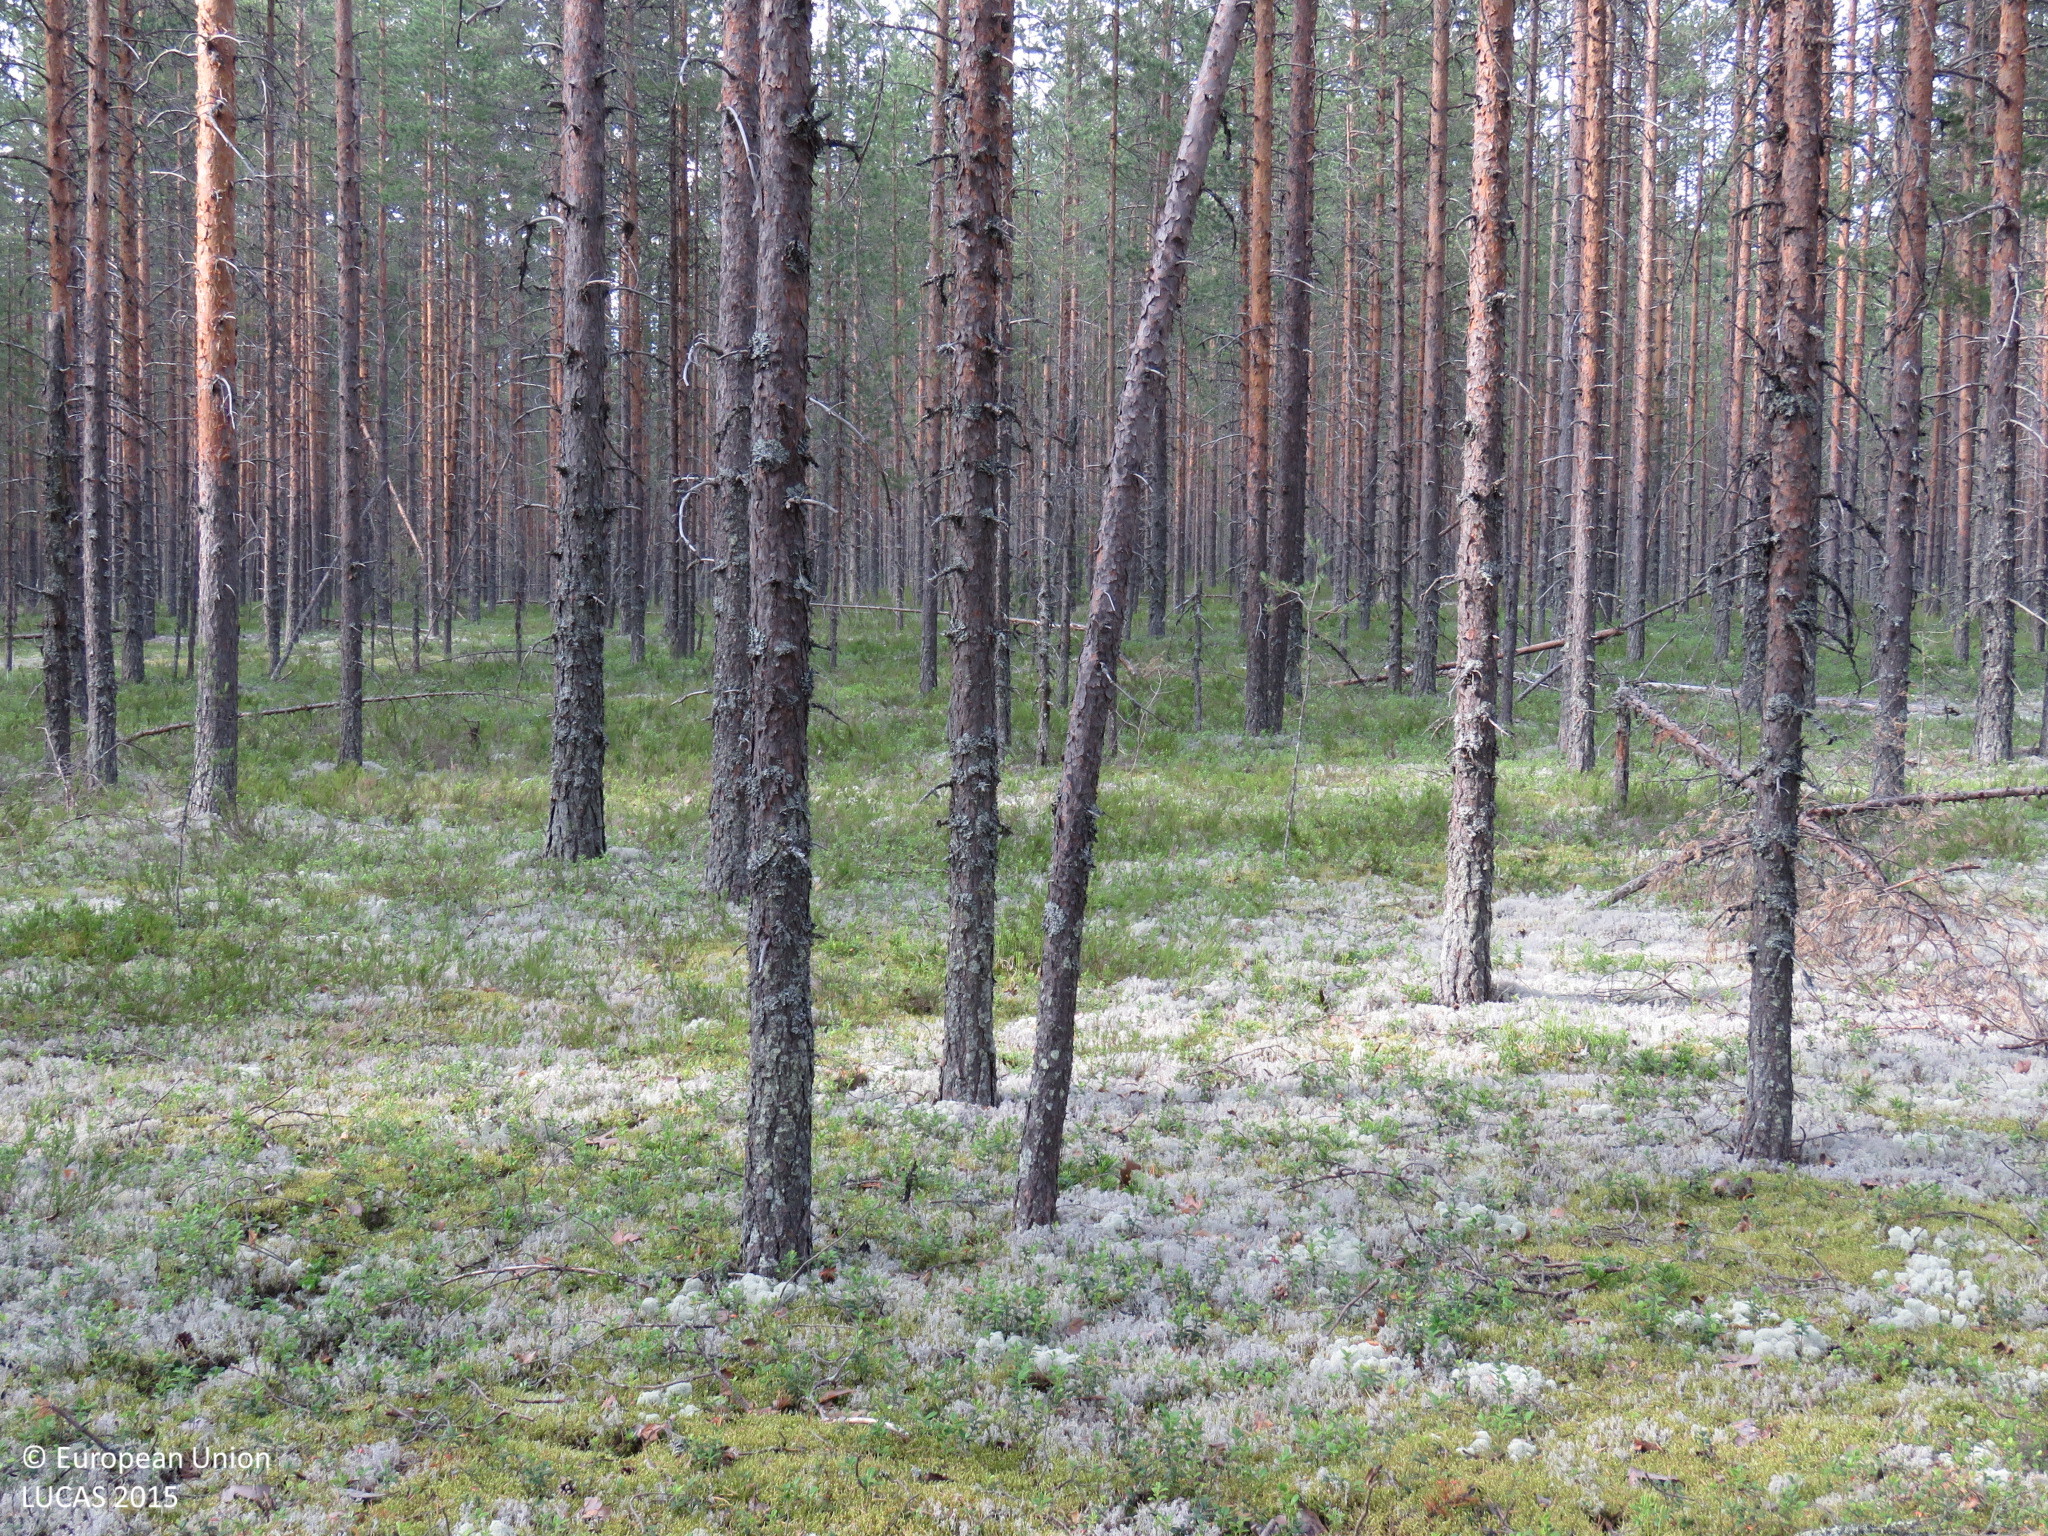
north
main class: Woodland
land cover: Pine dominated coniferous woodland
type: boreal forest
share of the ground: > 75 %
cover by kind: coniferous forest trees 80 %, shrubs 10 %, lichens and mosses 10 %
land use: Amenities, museums, leisure
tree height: > 5 m
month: July
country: FI
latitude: 64.5860
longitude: 26.4648
